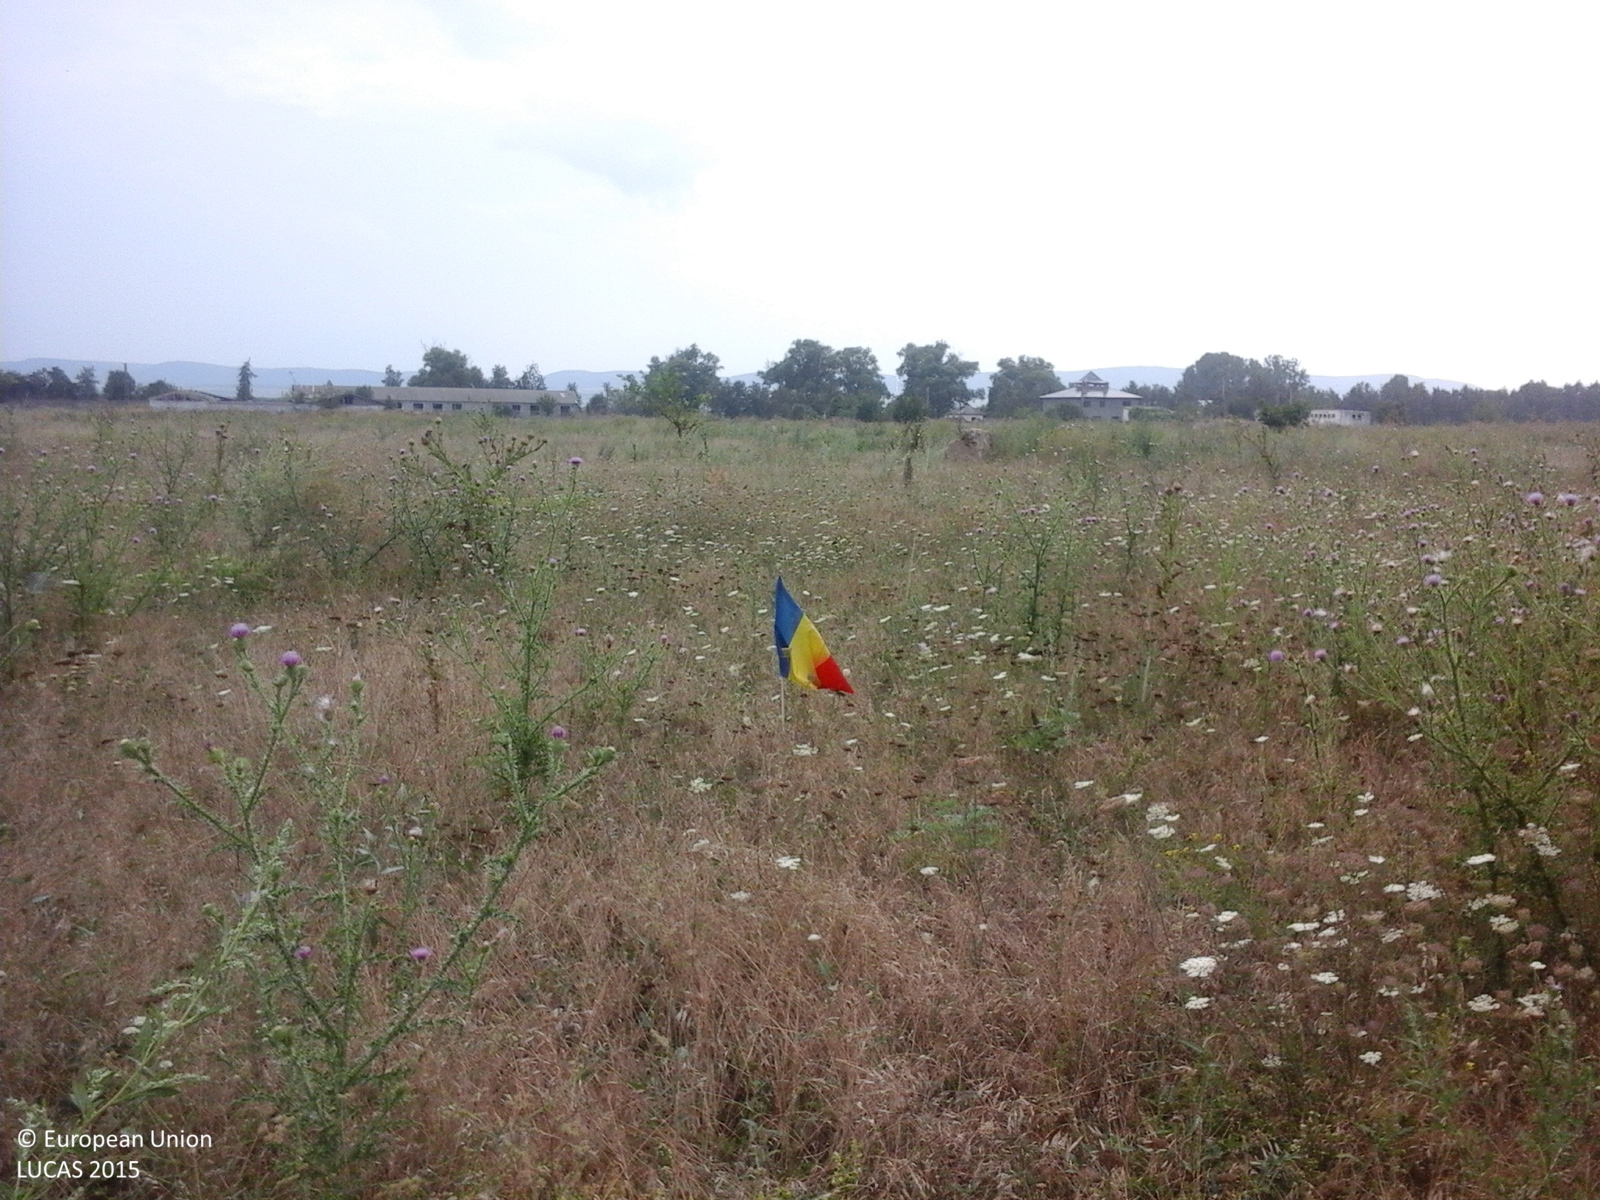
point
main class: Grassland
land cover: Spontaneously vegetated surfaces
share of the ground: > 75 %
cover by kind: herbaceous plants 100 %
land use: Fallow land
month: July
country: RO
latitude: 44.9451
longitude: 28.7808
